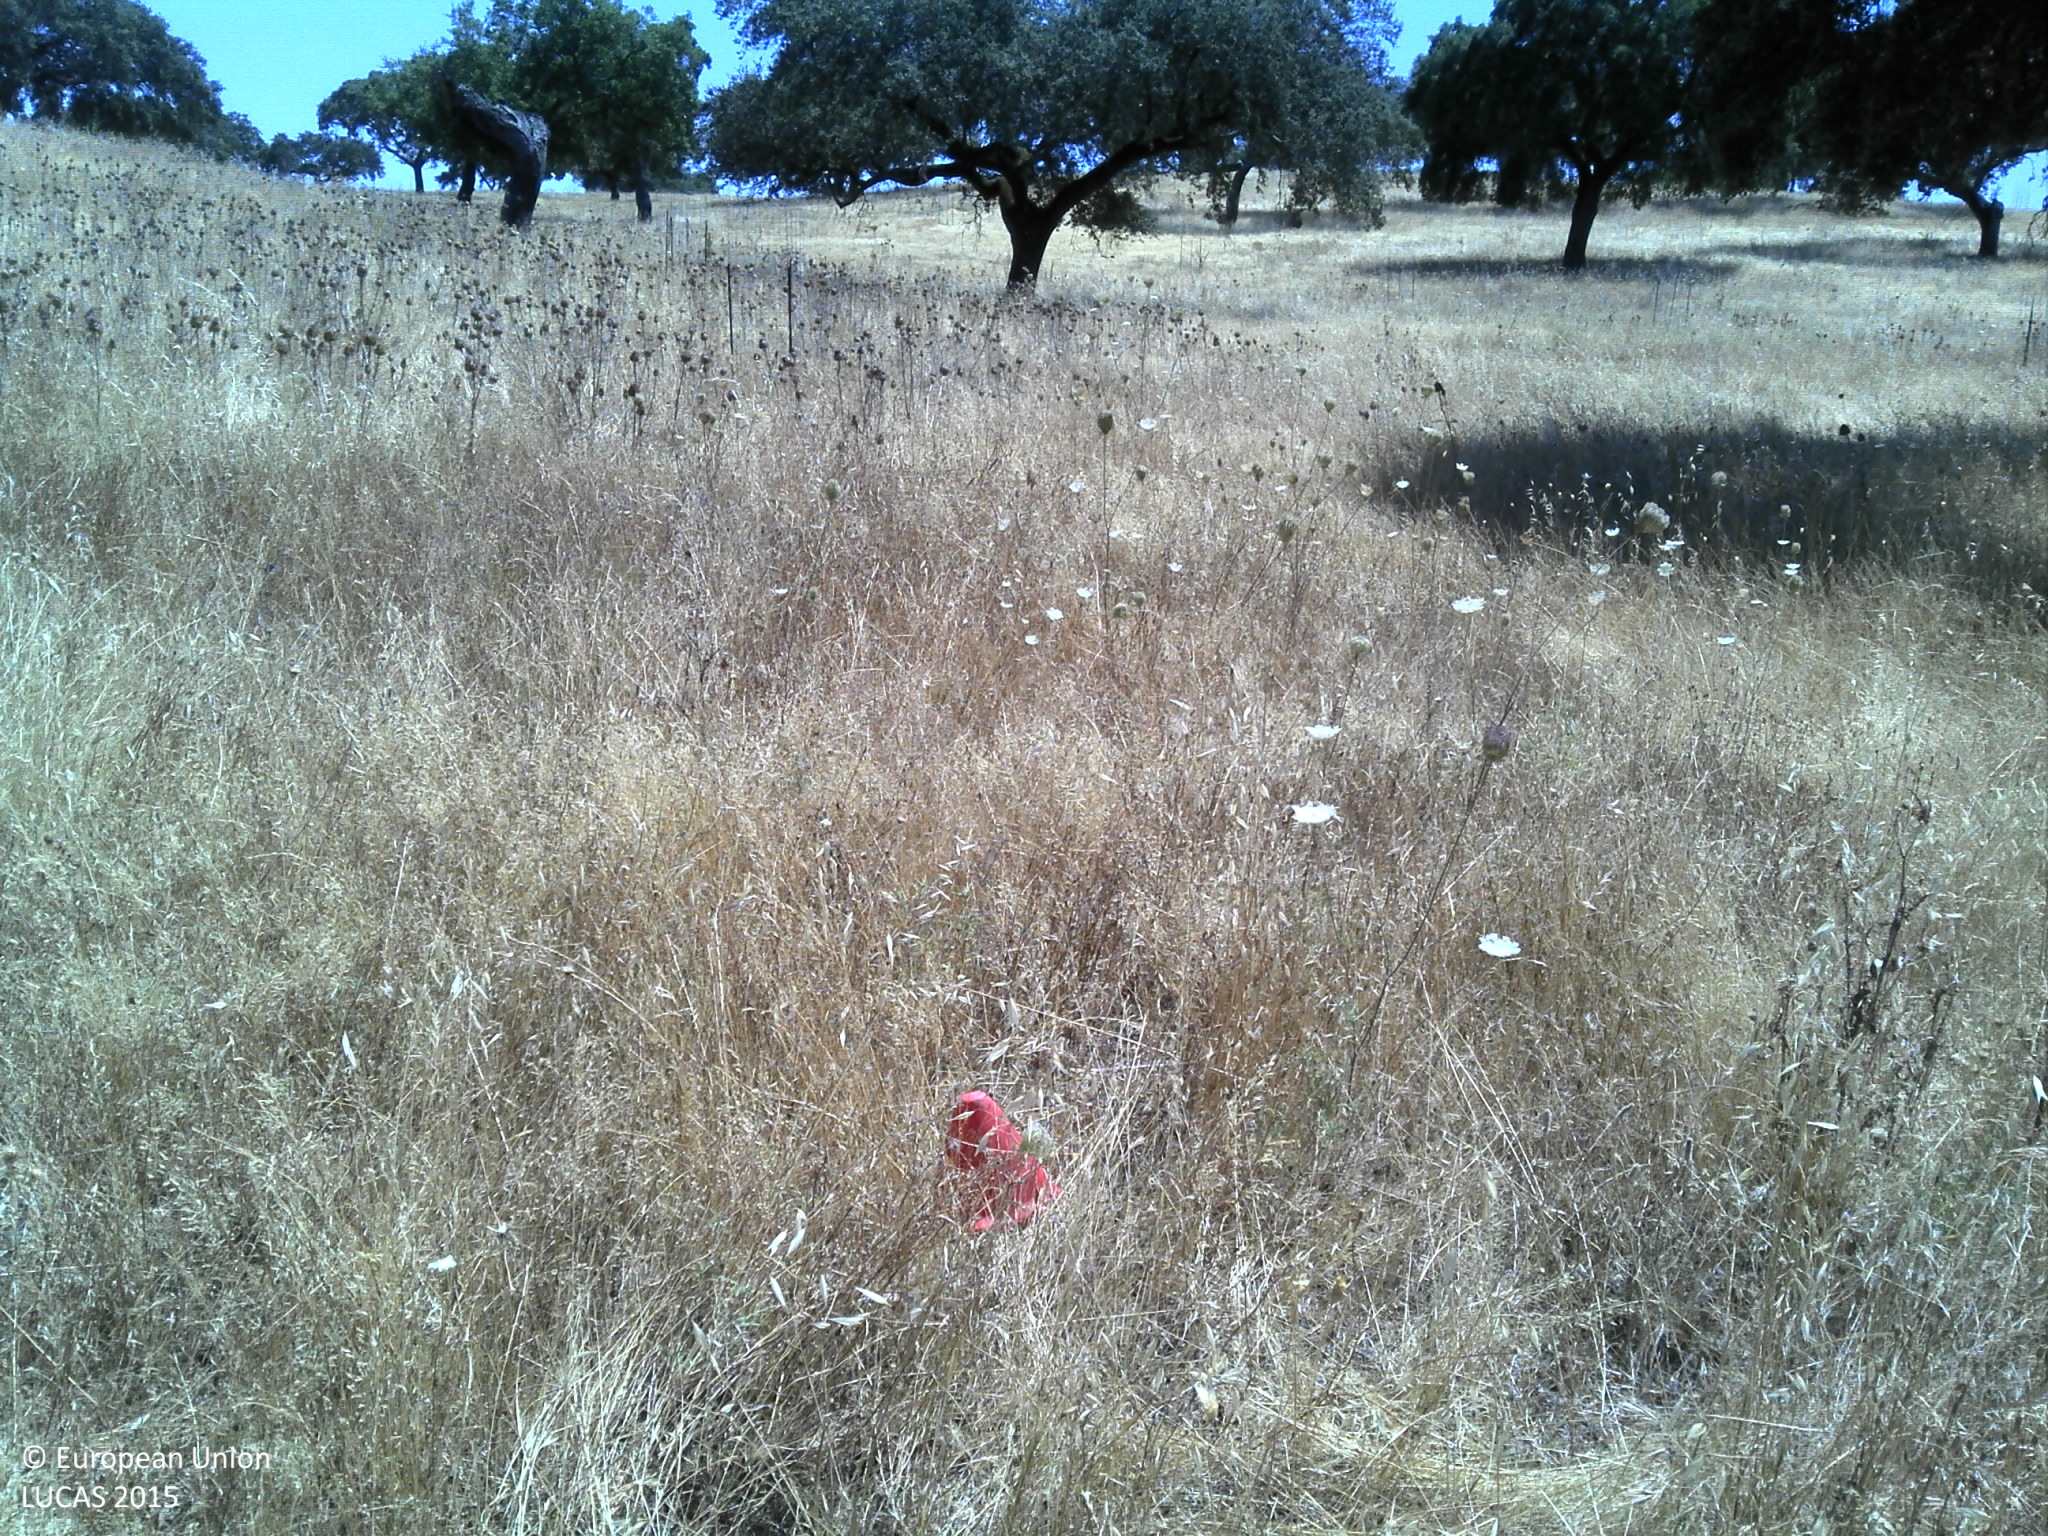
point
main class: Woodland
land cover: Broadleaved woodland
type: broadleaved evergreen forest
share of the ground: 25 - 50 %
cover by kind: herbaceous plants 70 %, broadleaved forest trees 30 %
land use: Forestry
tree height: > 5 m
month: June
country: PT
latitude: 37.9990
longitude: -7.2898
